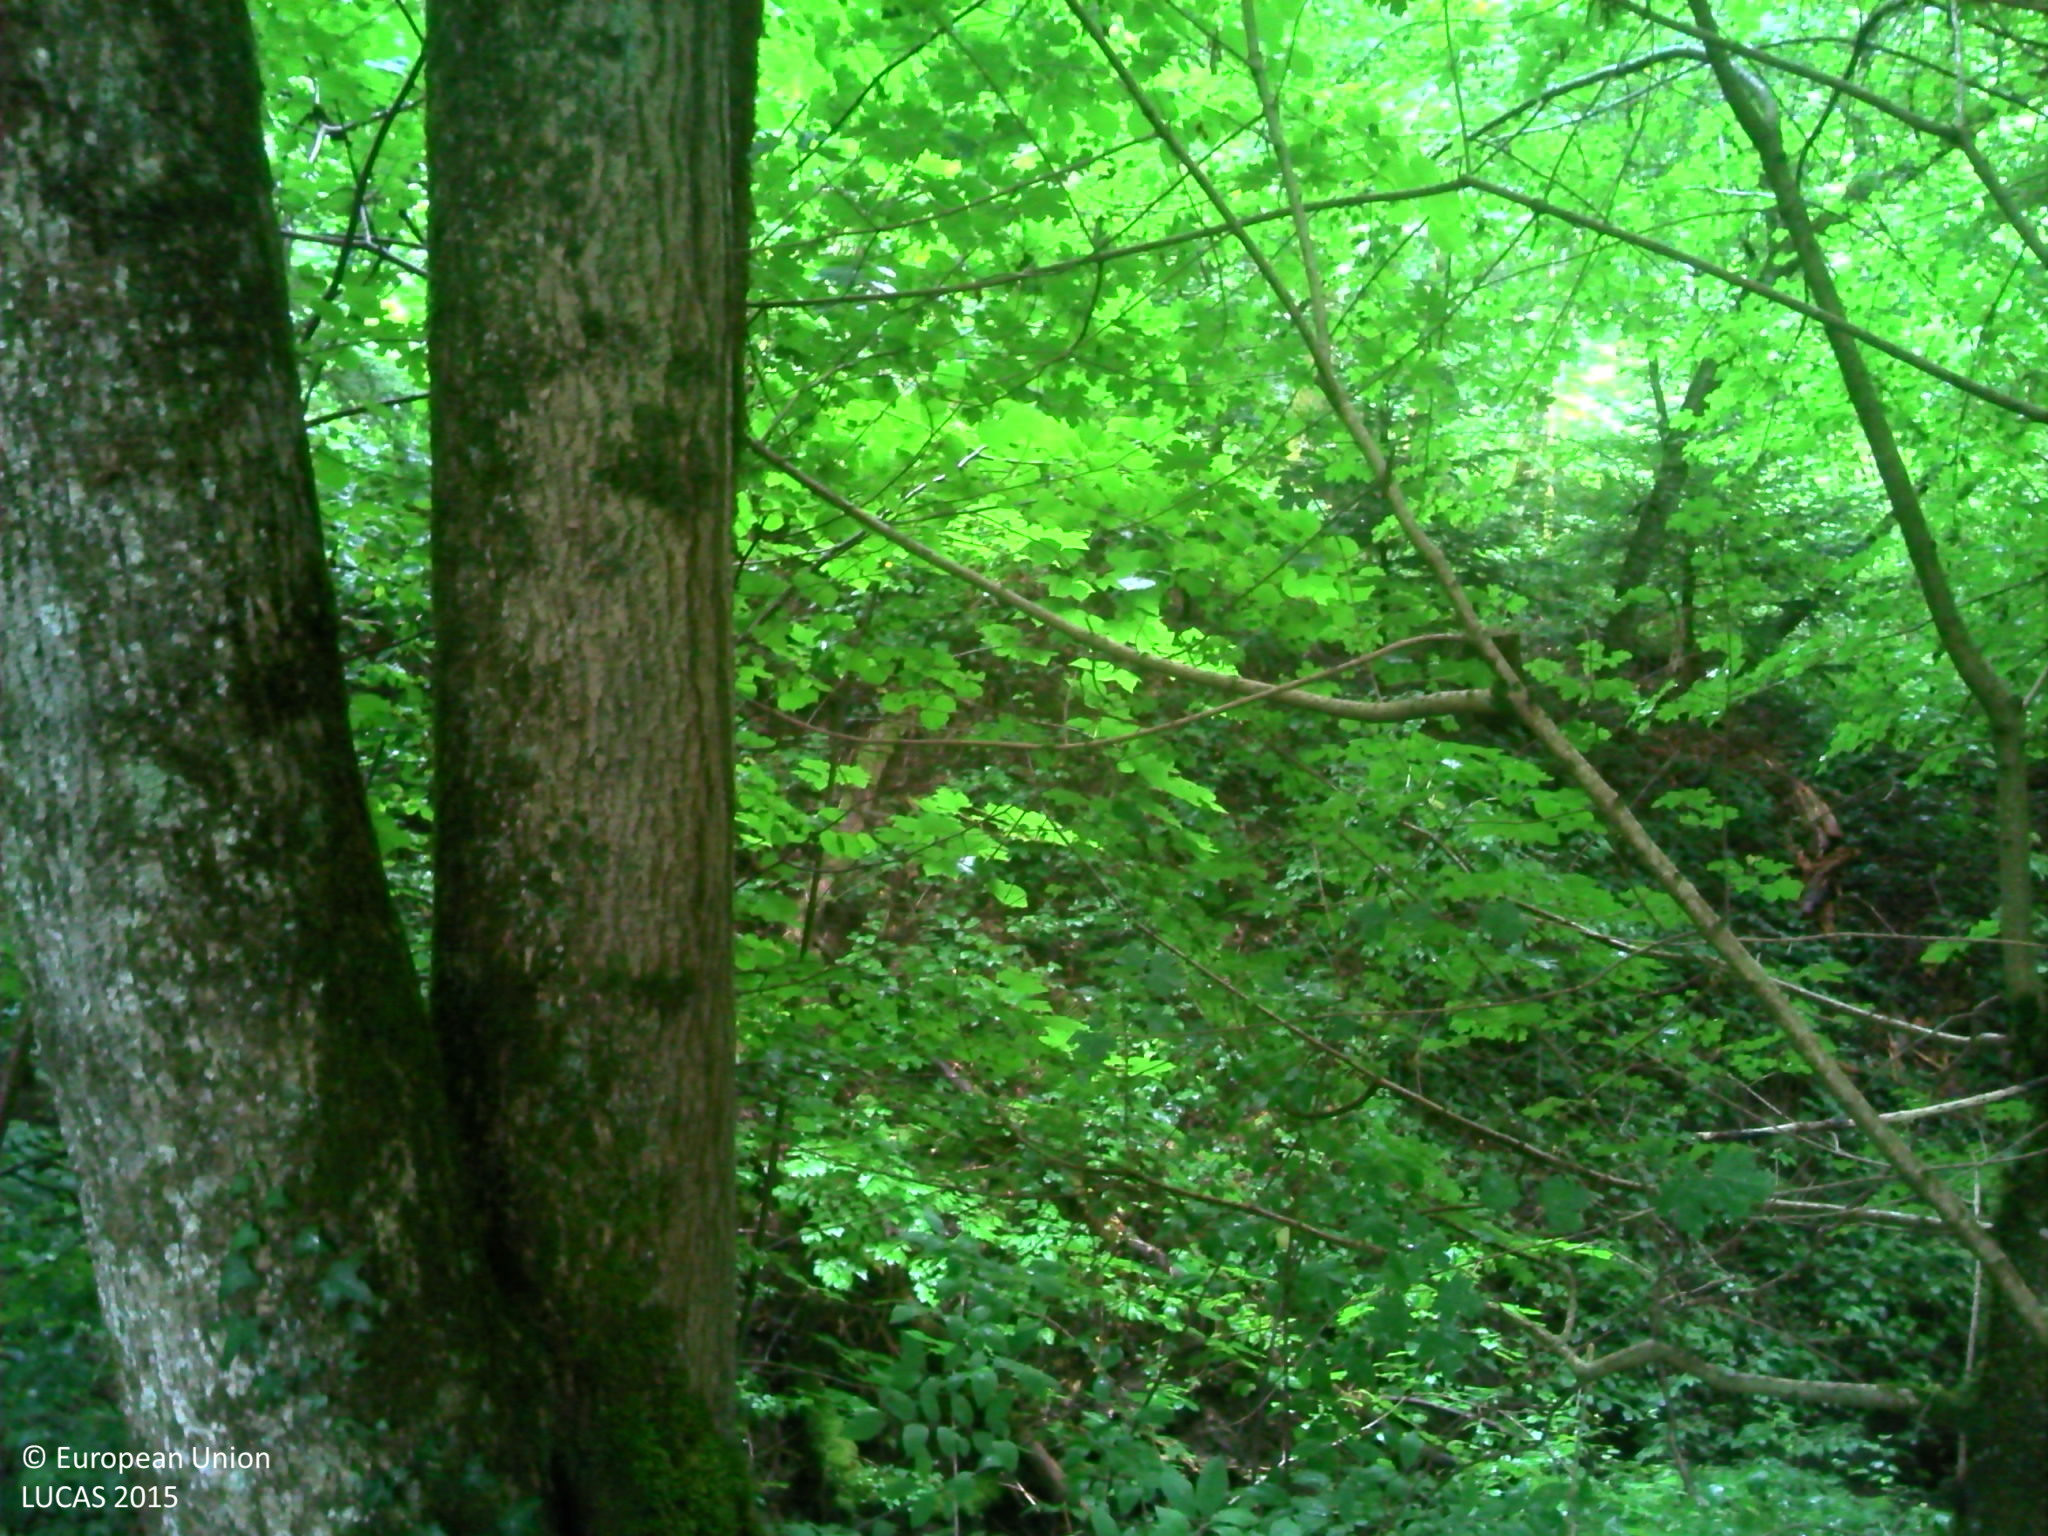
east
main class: Woodland
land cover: Broadleaved woodland
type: beech forest
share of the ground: > 75 %
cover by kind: broadleaved forest trees 65 %, coniferous forest trees 15 %, herbaceous plants 15 %, lichens and mosses 5 %
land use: Semi-natural and natural areas not in use
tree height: > 5 m
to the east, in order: Broadleaved woodland; Rivers and streams; Broadleaved woodland; Spontaneously vegetated surfaces; Broadleaved woodland; Fences; Grassland without tree/shrub cover; Electric lines; Grassland without tree/shrub cover
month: July
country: FR
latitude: 45.9770
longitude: 6.1963
